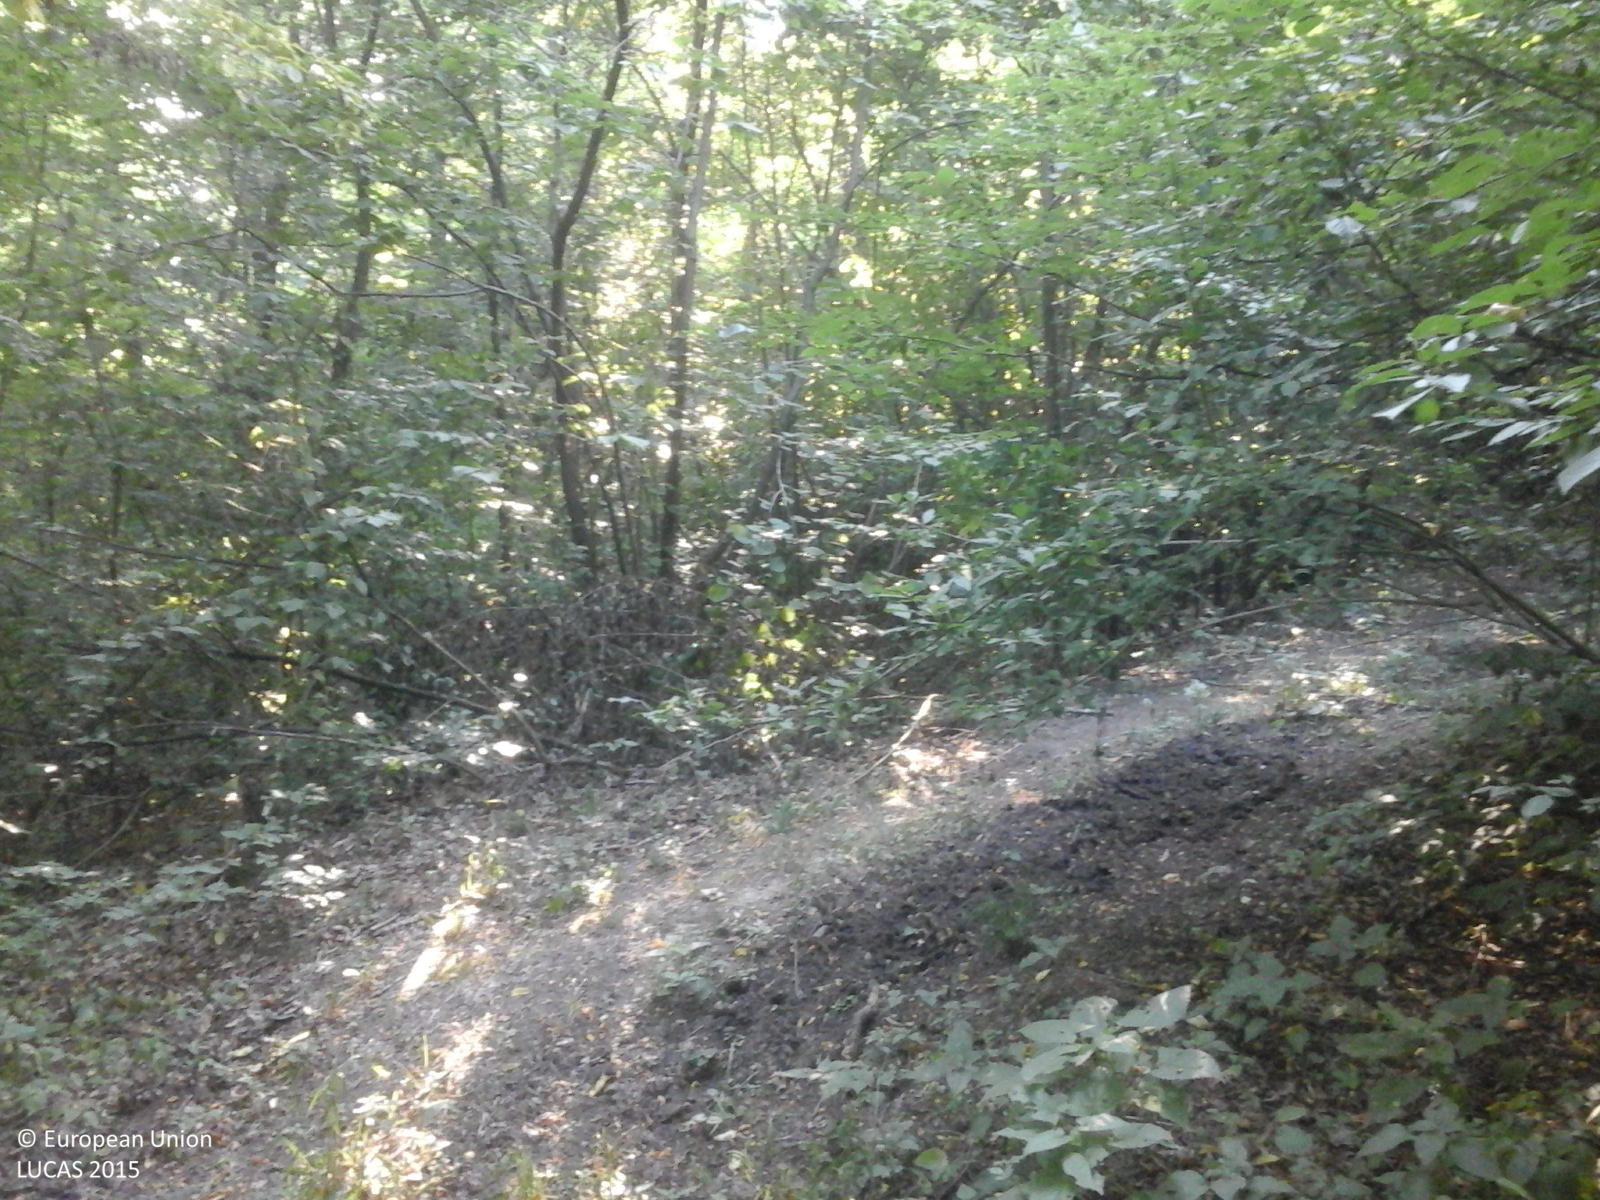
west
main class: Woodland
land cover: Broadleaved woodland
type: beech forest
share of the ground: > 75 %
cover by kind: broadleaved forest trees 95 %, herbaceous plants 5 %
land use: Forestry
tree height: > 5 m
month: July
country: RO
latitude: 45.0126
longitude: 24.7356
